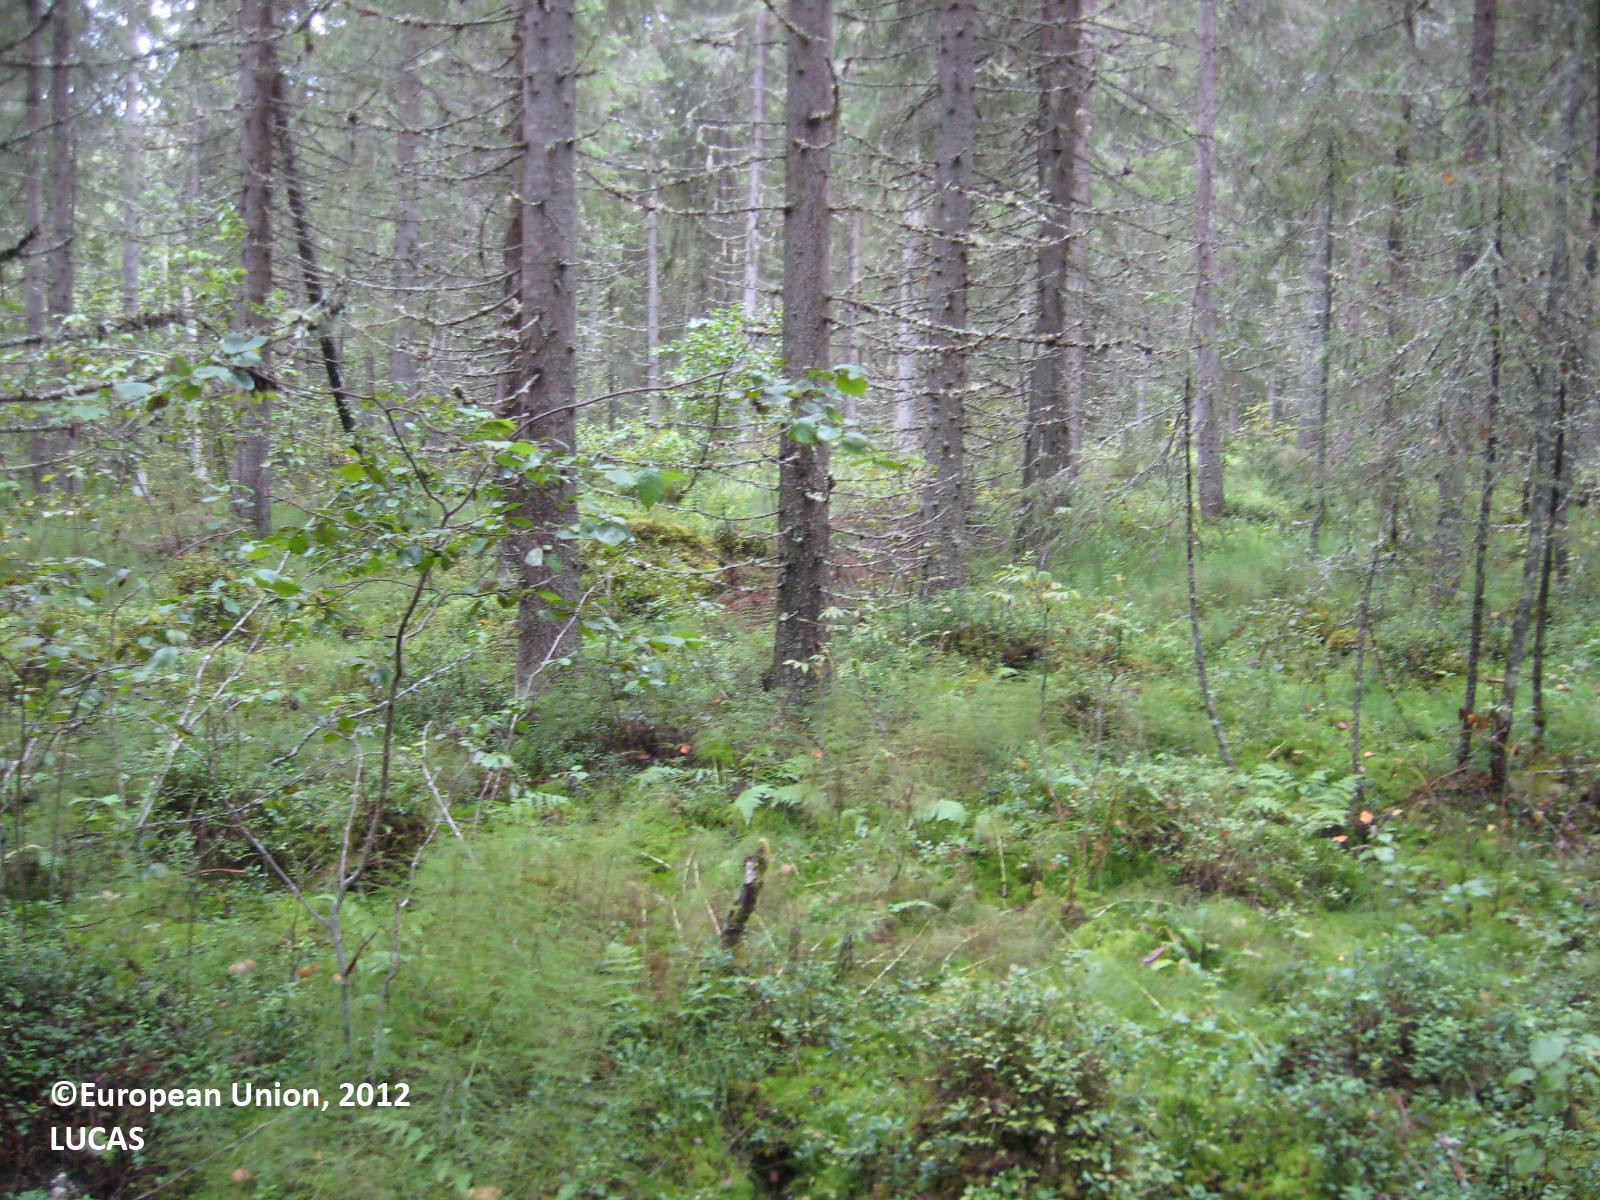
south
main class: Woodland
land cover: Spruce dominated coniferous woodland
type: boreal forest
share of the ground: > 75 %
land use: Forestry
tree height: > 5 m
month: August
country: FI
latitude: 63.4833
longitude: 29.5214
